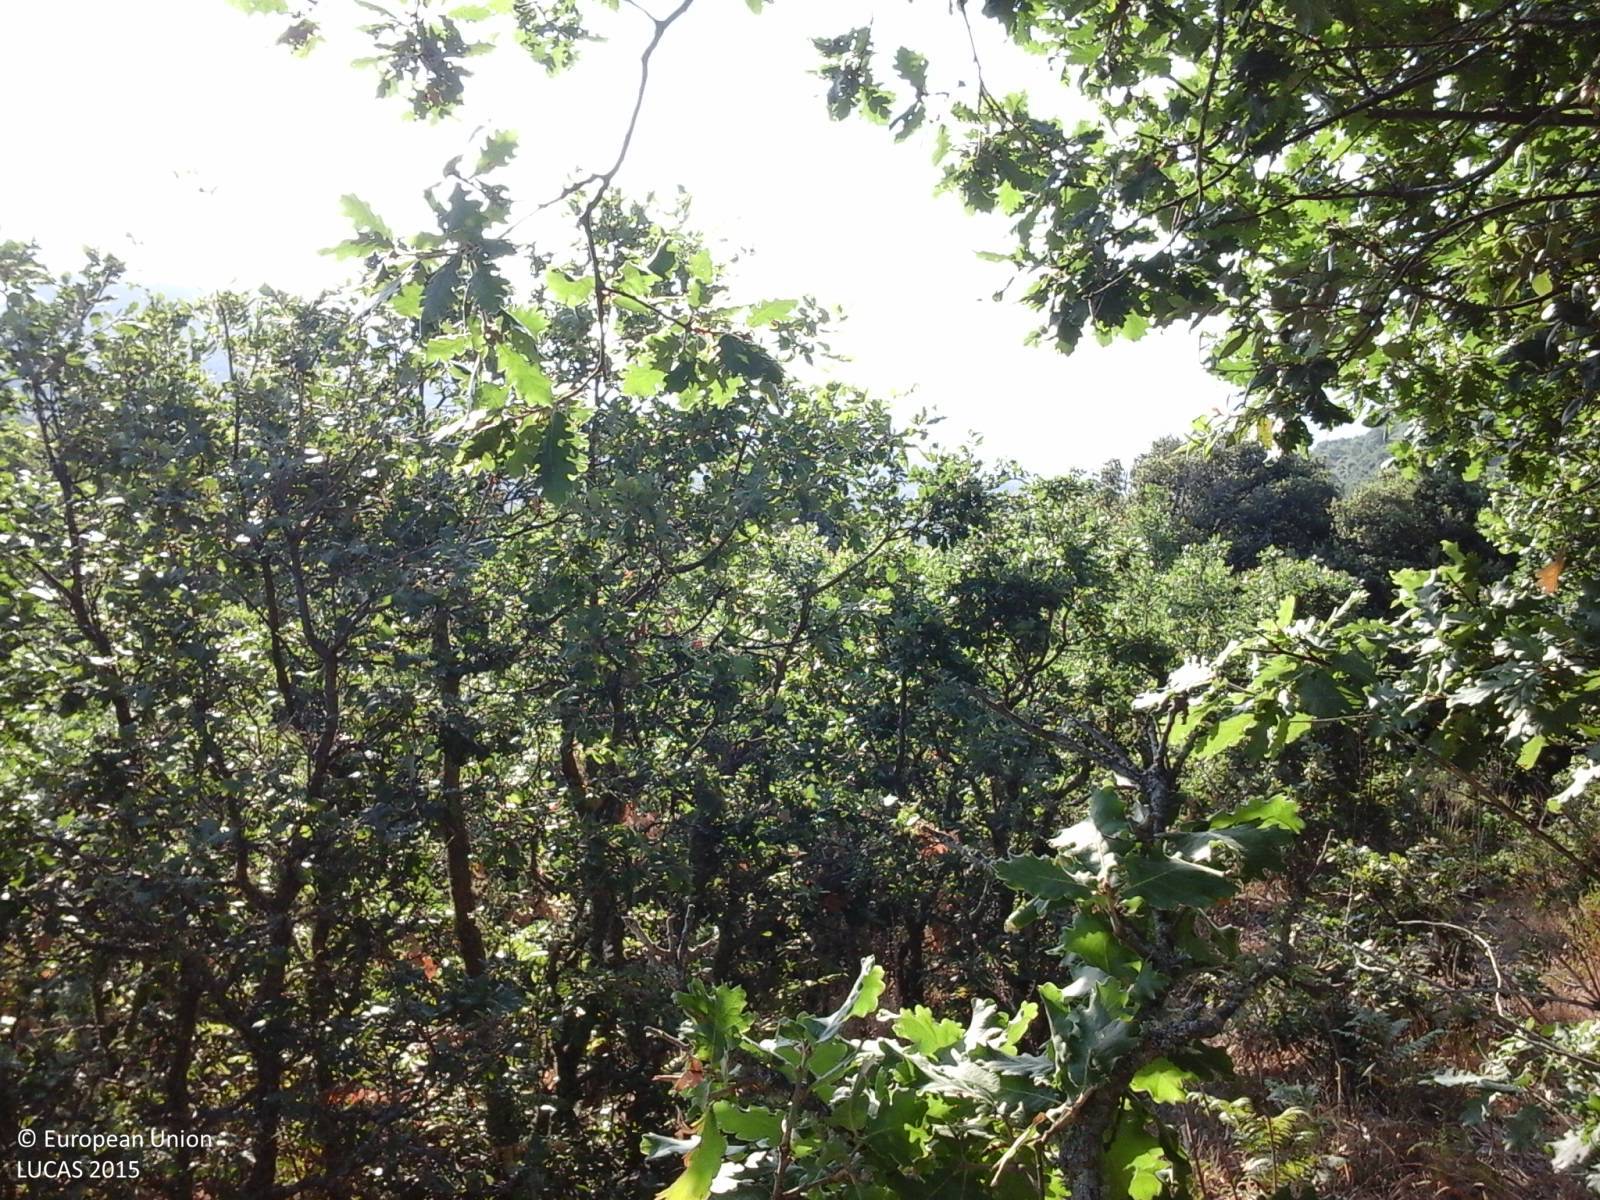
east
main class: Woodland
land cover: Broadleaved woodland
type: thermophilous deciduous forest
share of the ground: 25 - 50 %
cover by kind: broadleaved forest trees 45 %, herbaceous plants 35 %, shrubs 20 %
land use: Agriculture (excluding fallow land and kitchen gardens)
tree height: < 5 m
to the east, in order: Broadleaved woodland; Tracks; Broadleaved woodland; Tracks; Shrubland with sparse tree cover; Broadleaved woodland; Rivers and streams; Broadleaved woodland; Grassland with sparse tree/shrub cover
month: July
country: IT
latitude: 40.4725
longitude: 8.4626
